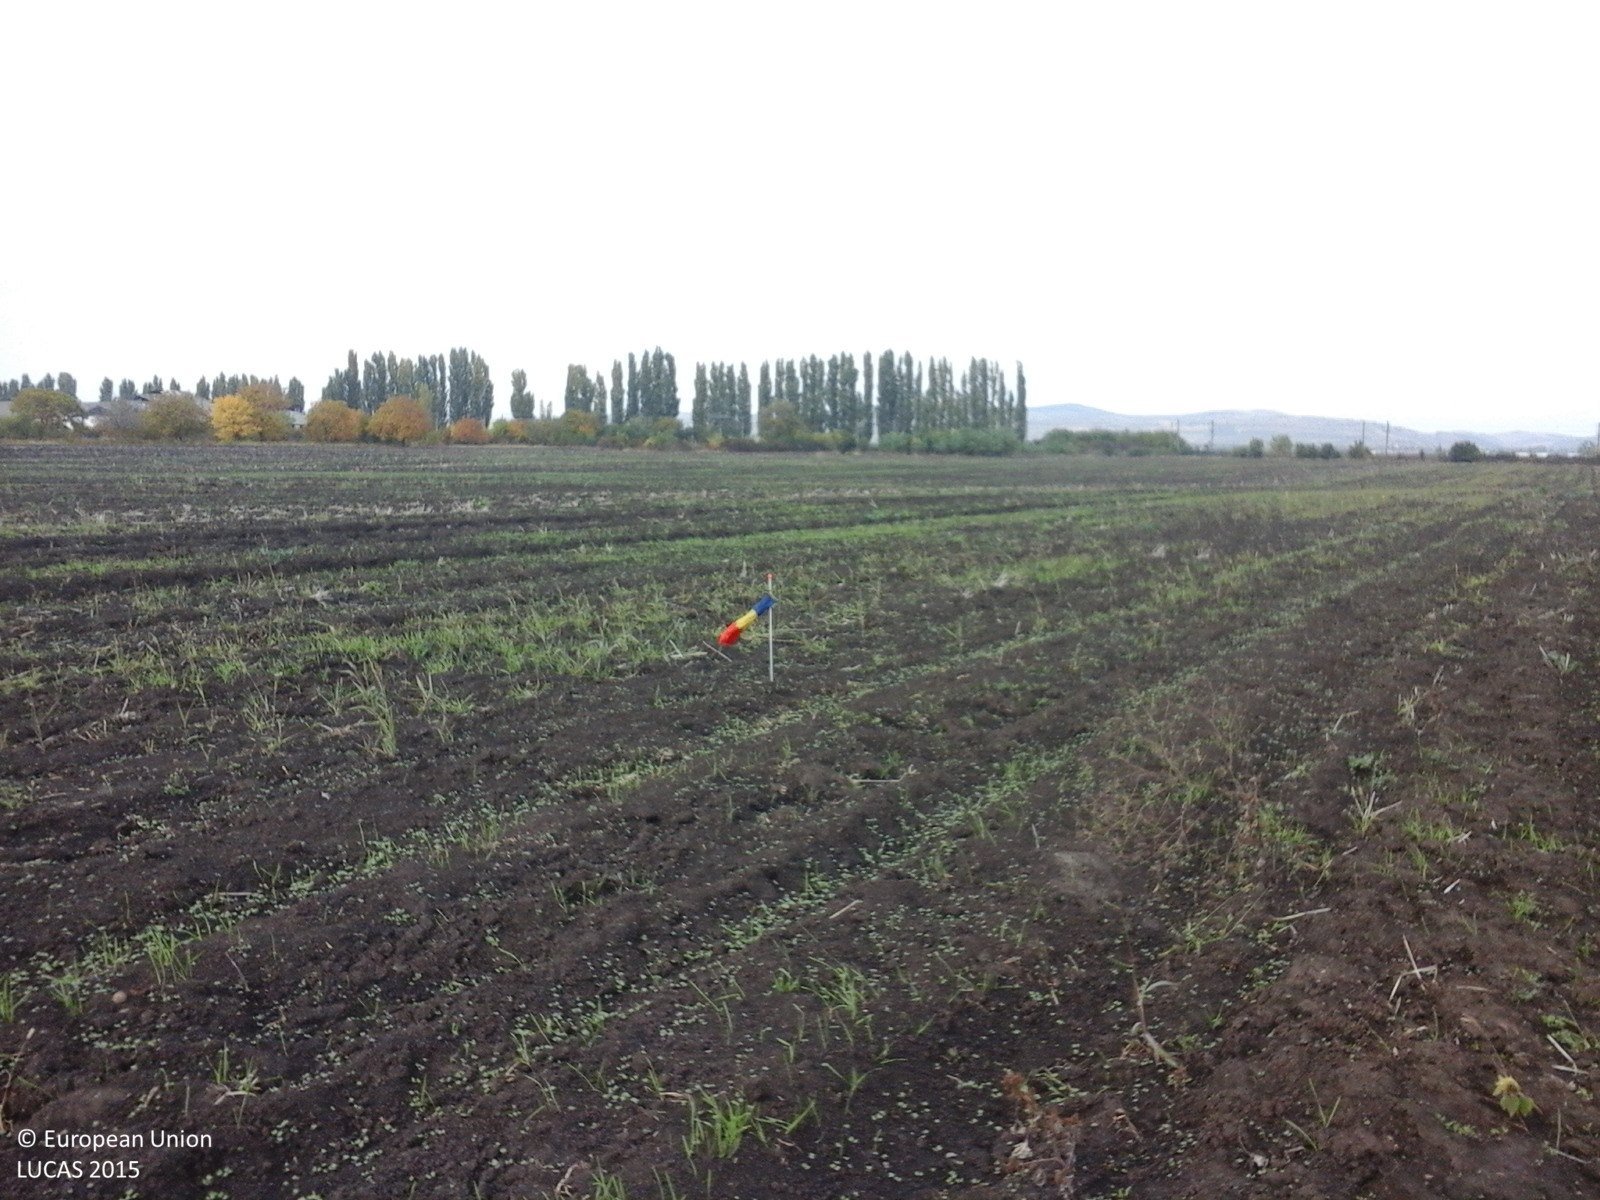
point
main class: Cropland
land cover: Common wheat
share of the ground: < 10 %
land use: Agriculture (excluding fallow land and kitchen gardens)
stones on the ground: < 10 %
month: October
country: RO
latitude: 44.9706
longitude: 26.3591
